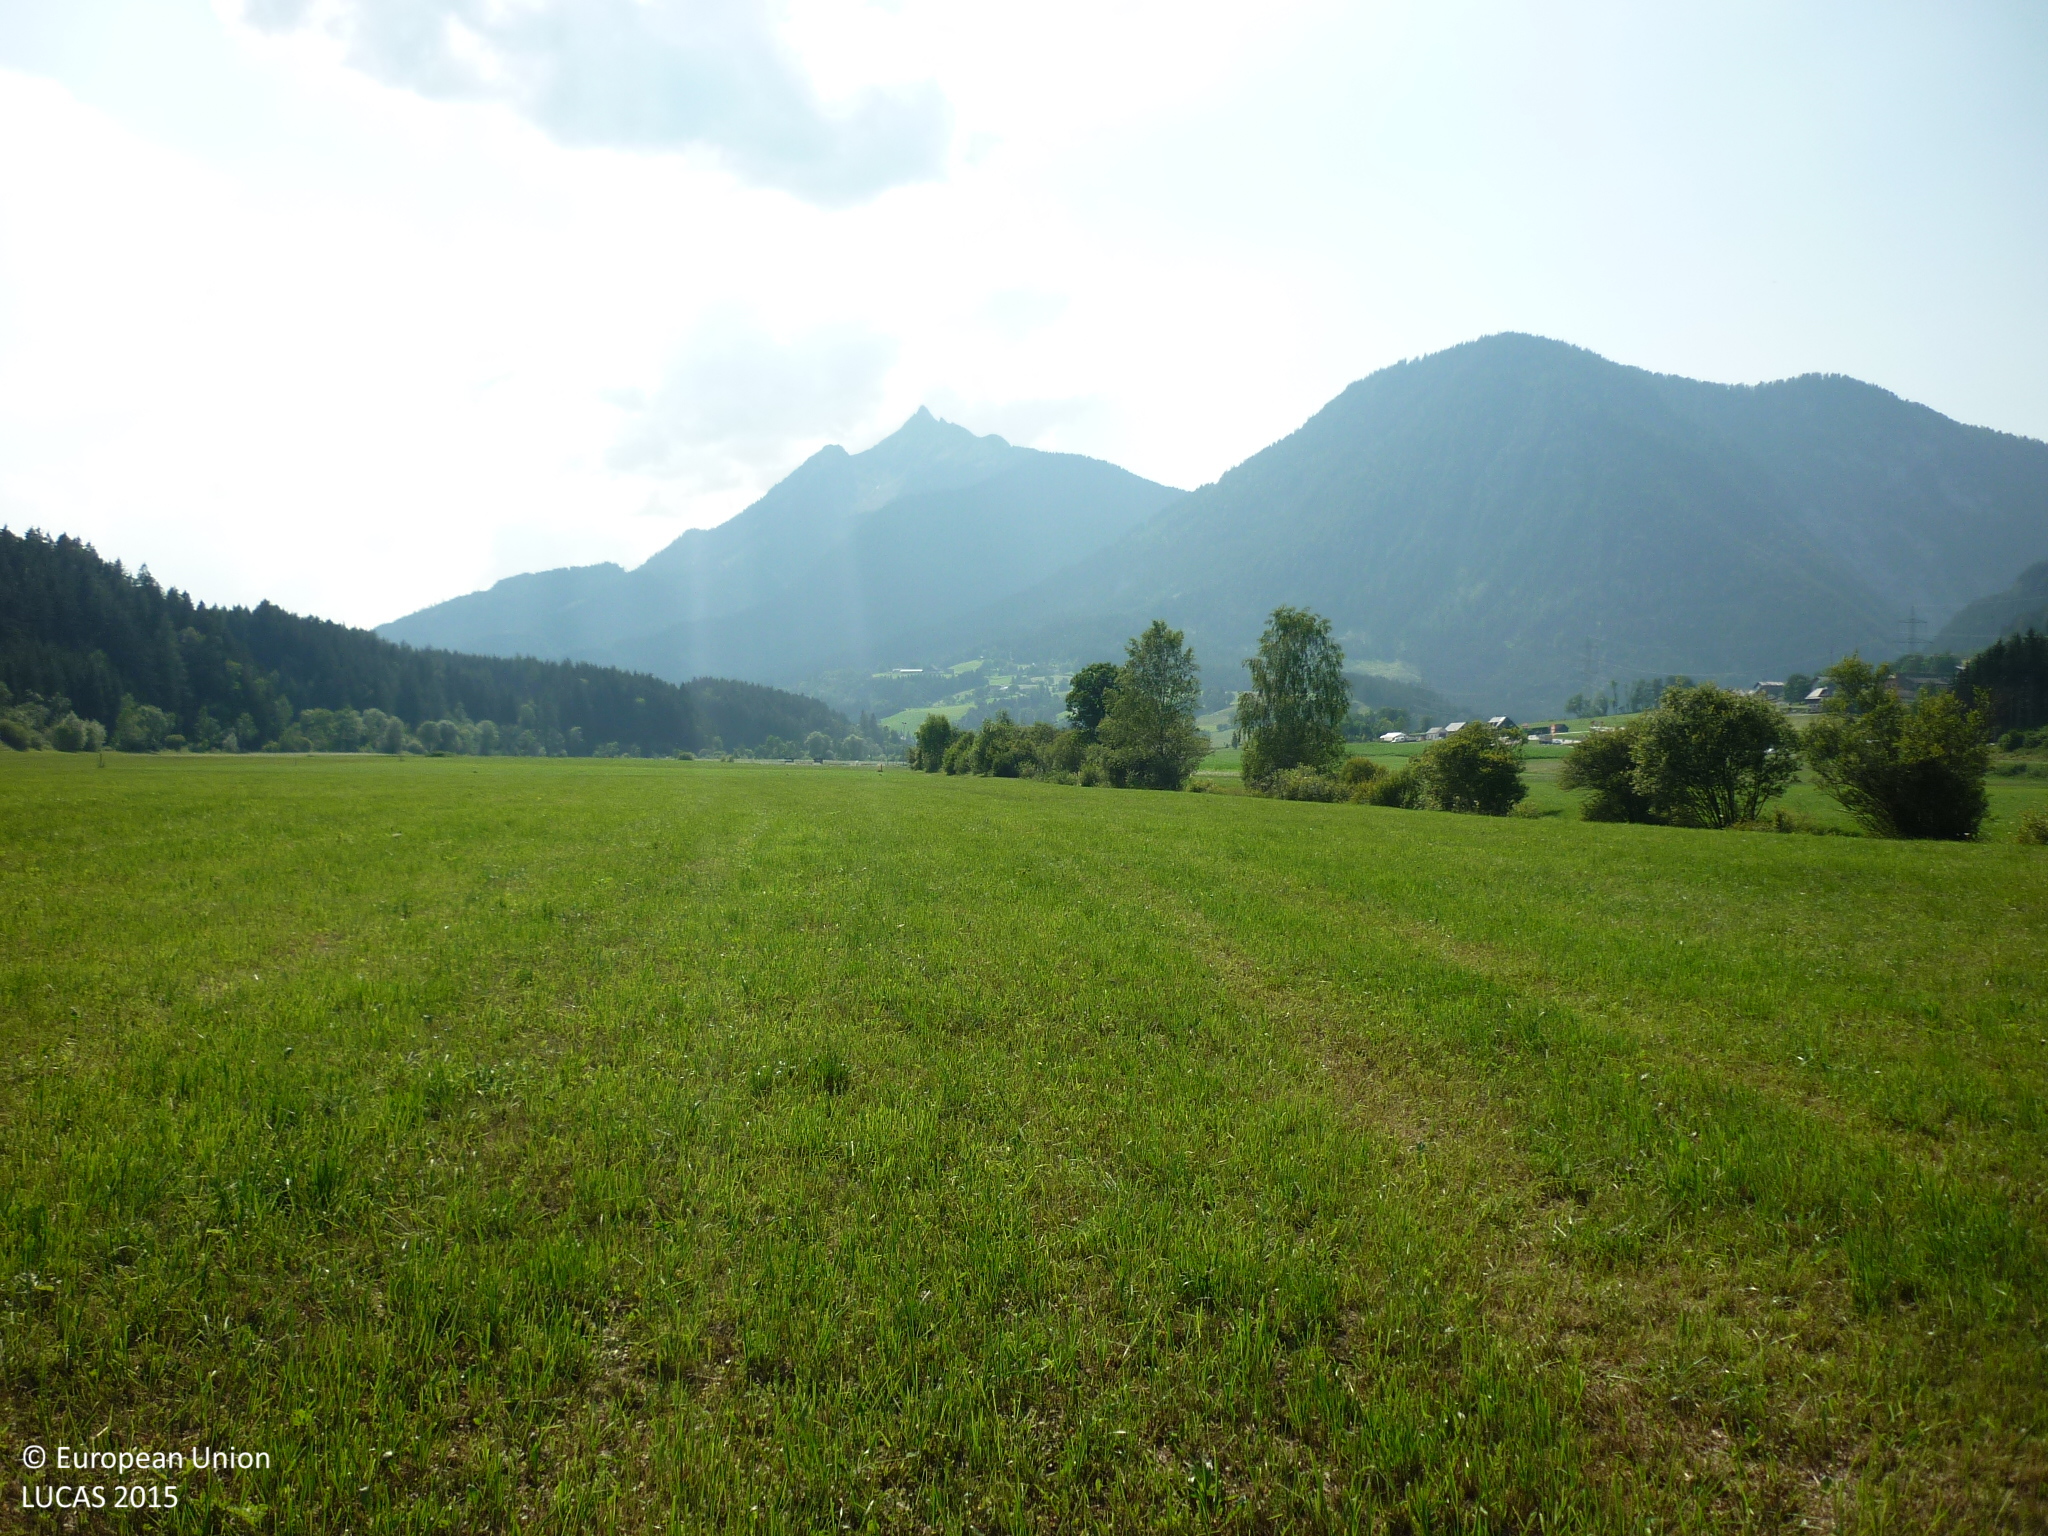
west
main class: Grassland
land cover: Grassland without tree/shrub cover
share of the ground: > 75 %
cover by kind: herbaceous plants 100 %
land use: Agriculture (excluding fallow land and kitchen gardens)
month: July
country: AT
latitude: 47.4845
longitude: 13.9933
